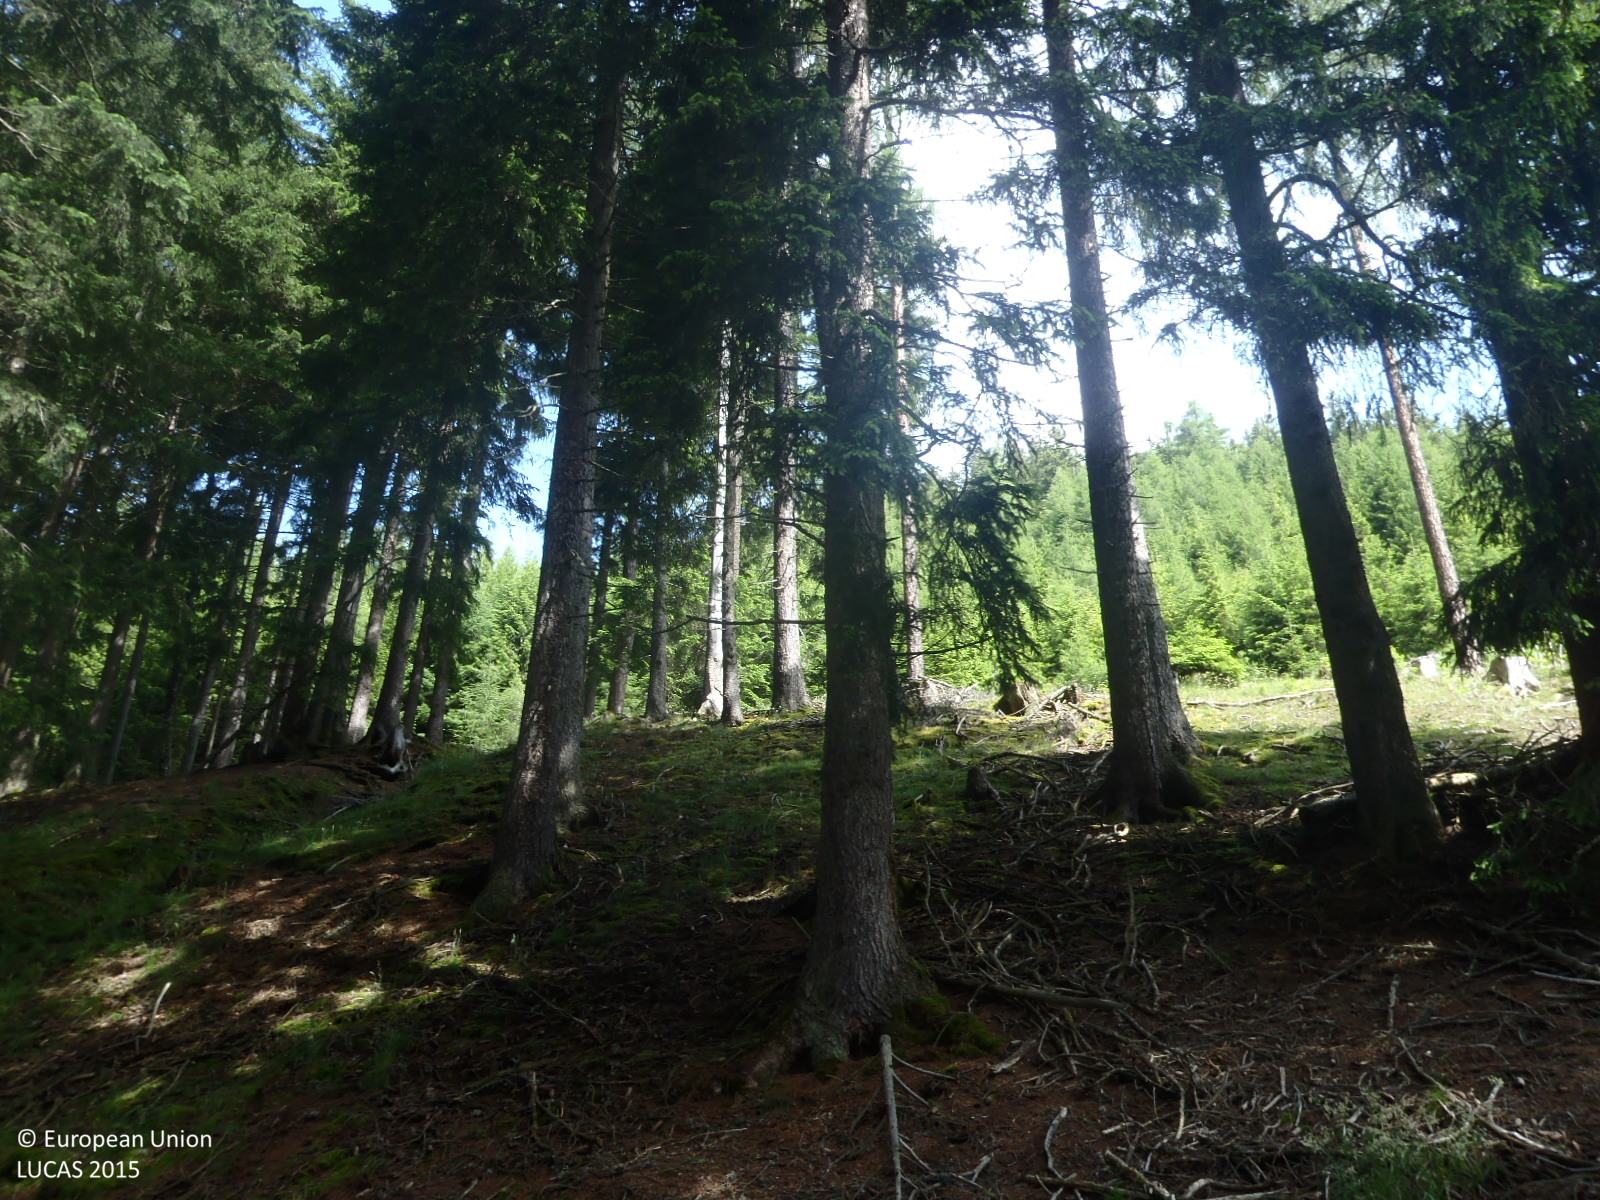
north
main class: Woodland
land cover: Spruce dominated coniferous woodland
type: alpine coniferous forest
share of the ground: > 75 %
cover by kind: coniferous forest trees 90 %, herbaceous plants 5 %, lichens and mosses 5 %
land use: Forestry
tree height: > 5 m
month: June
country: AT
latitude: 47.1697
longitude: 11.4630
